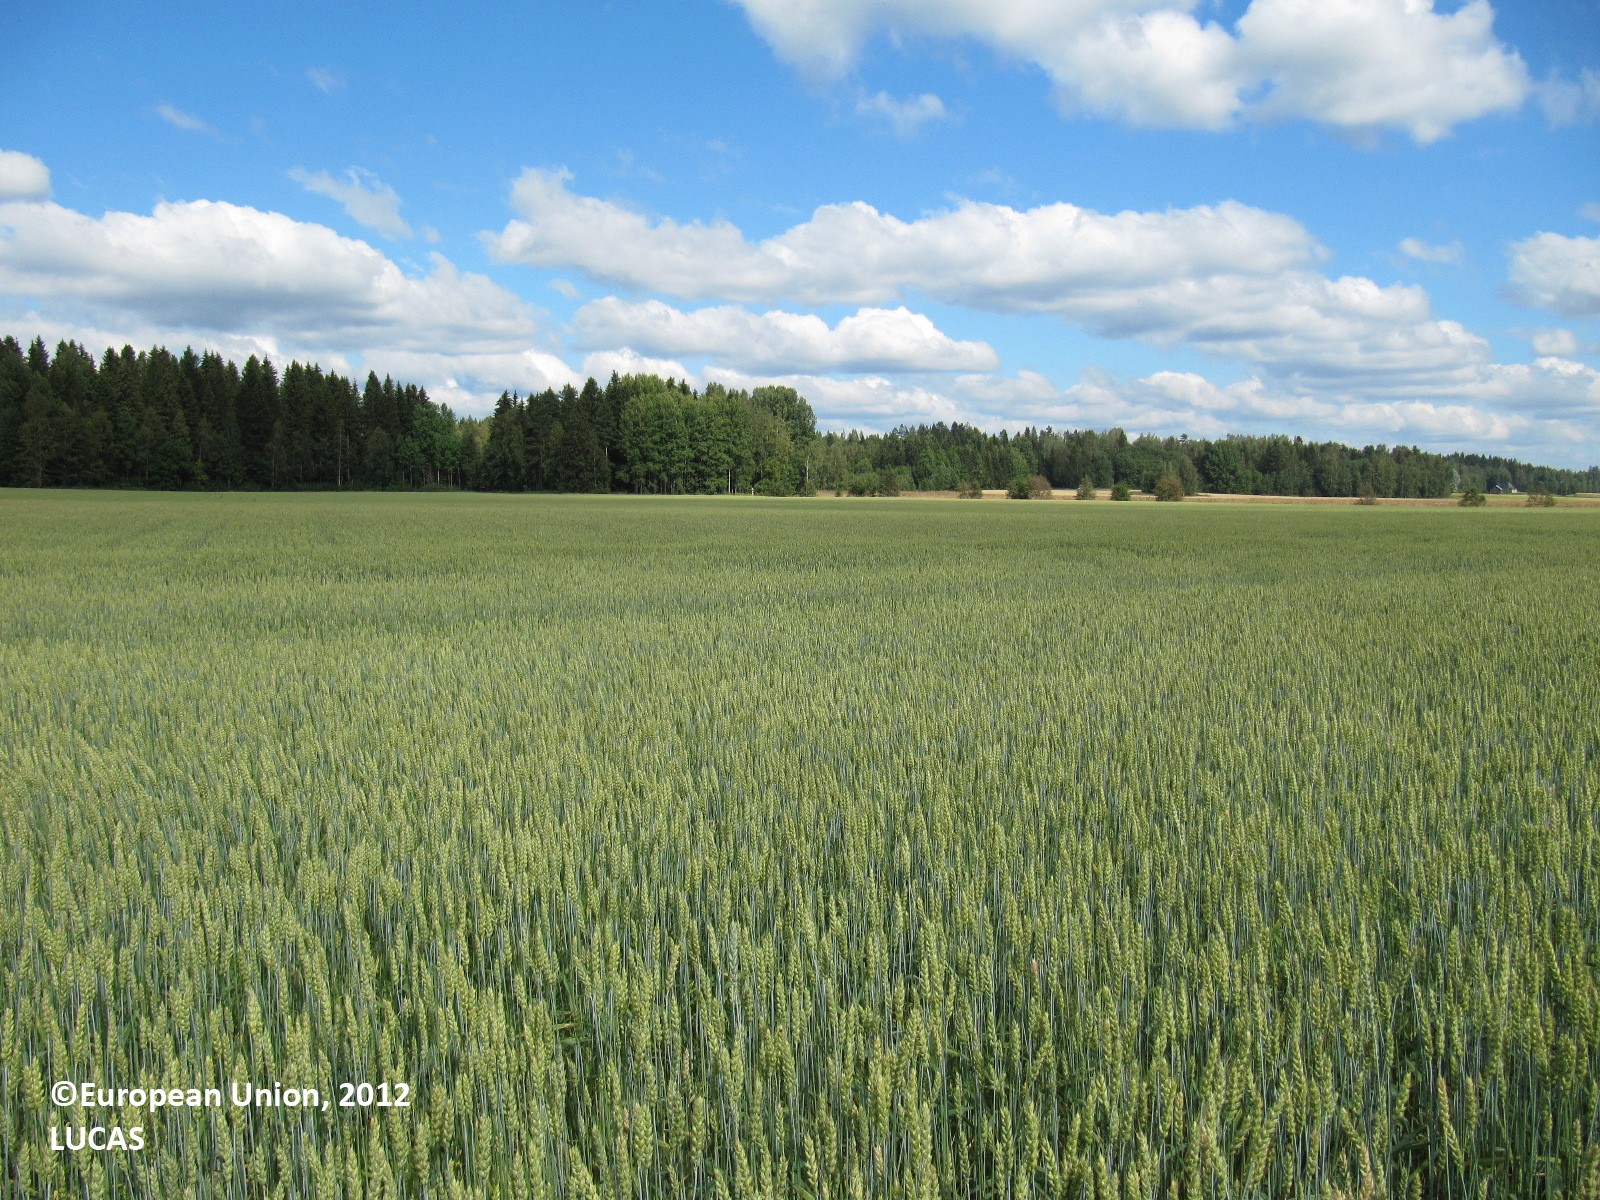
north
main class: Cropland
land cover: Common wheat
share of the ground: > 75 %
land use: Agriculture (excluding fallow land and kitchen gardens)
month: August
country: FI
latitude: 60.4687
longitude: 24.5303
